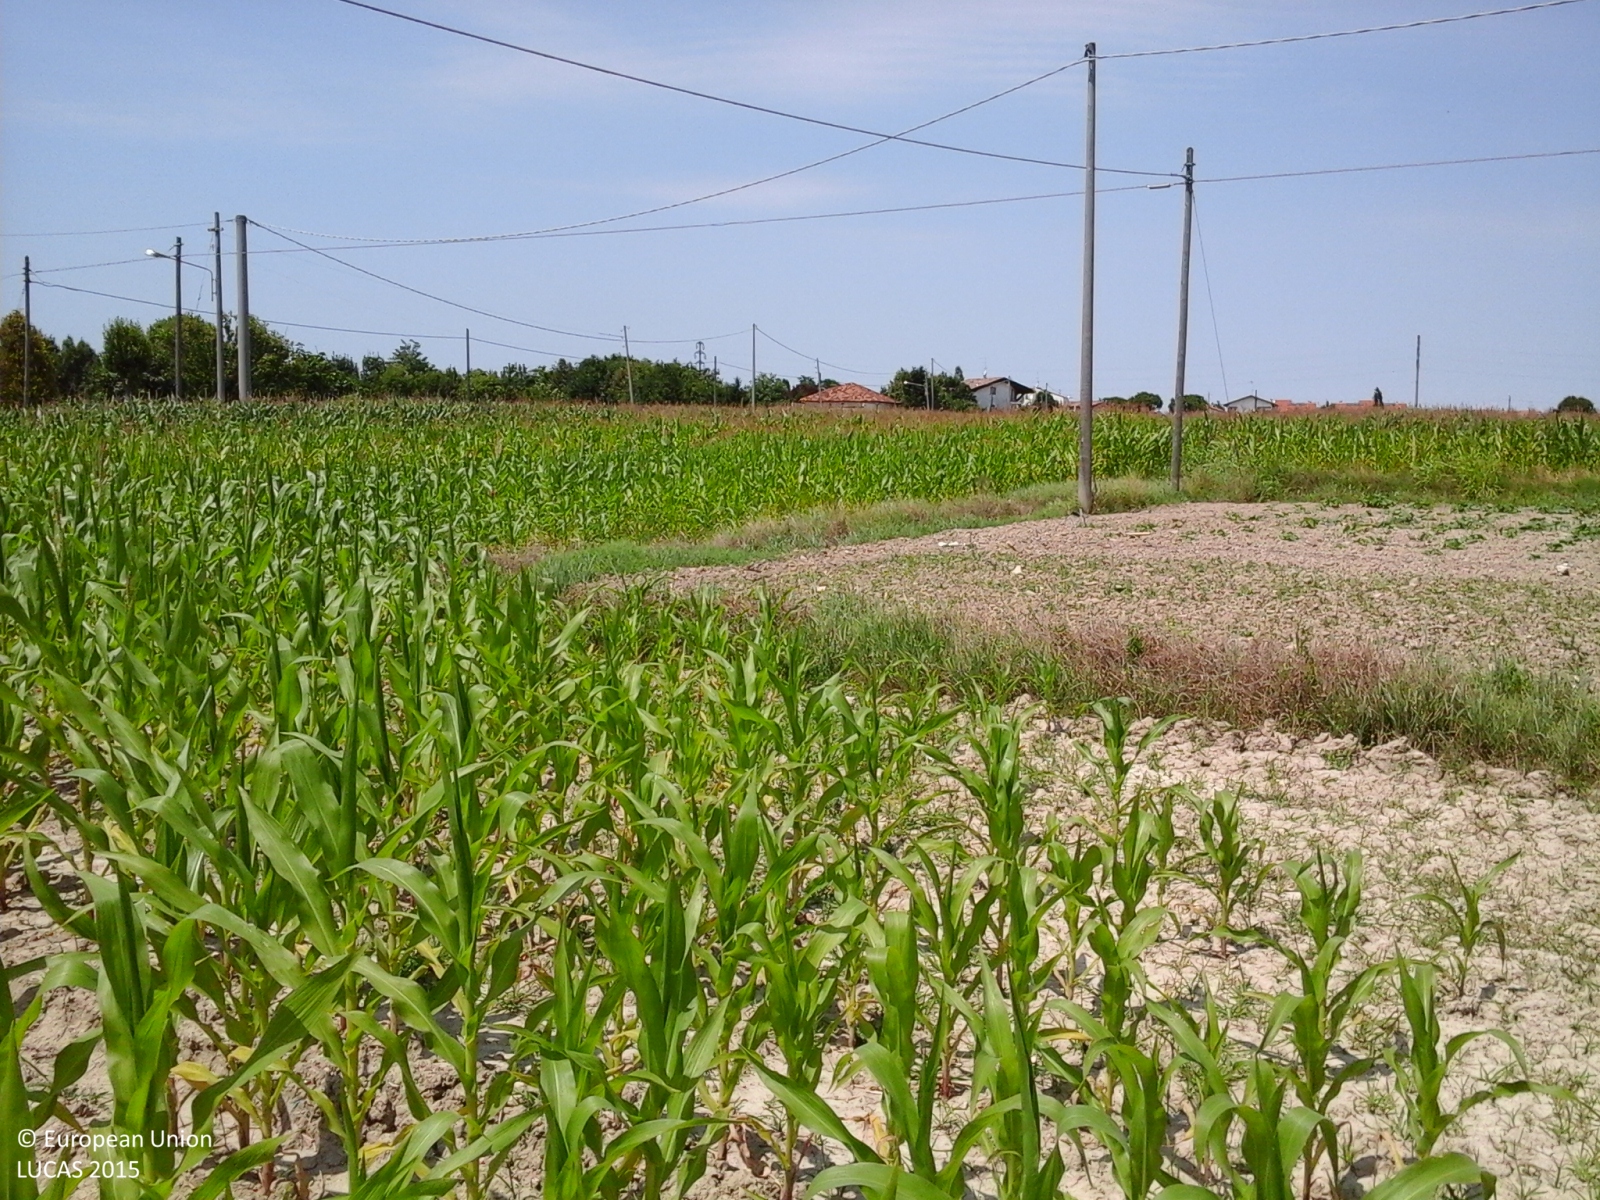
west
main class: Cropland
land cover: Maize
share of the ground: > 75 %
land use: Agriculture (excluding fallow land and kitchen gardens)
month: June
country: IT
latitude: 44.1788
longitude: 12.3838
